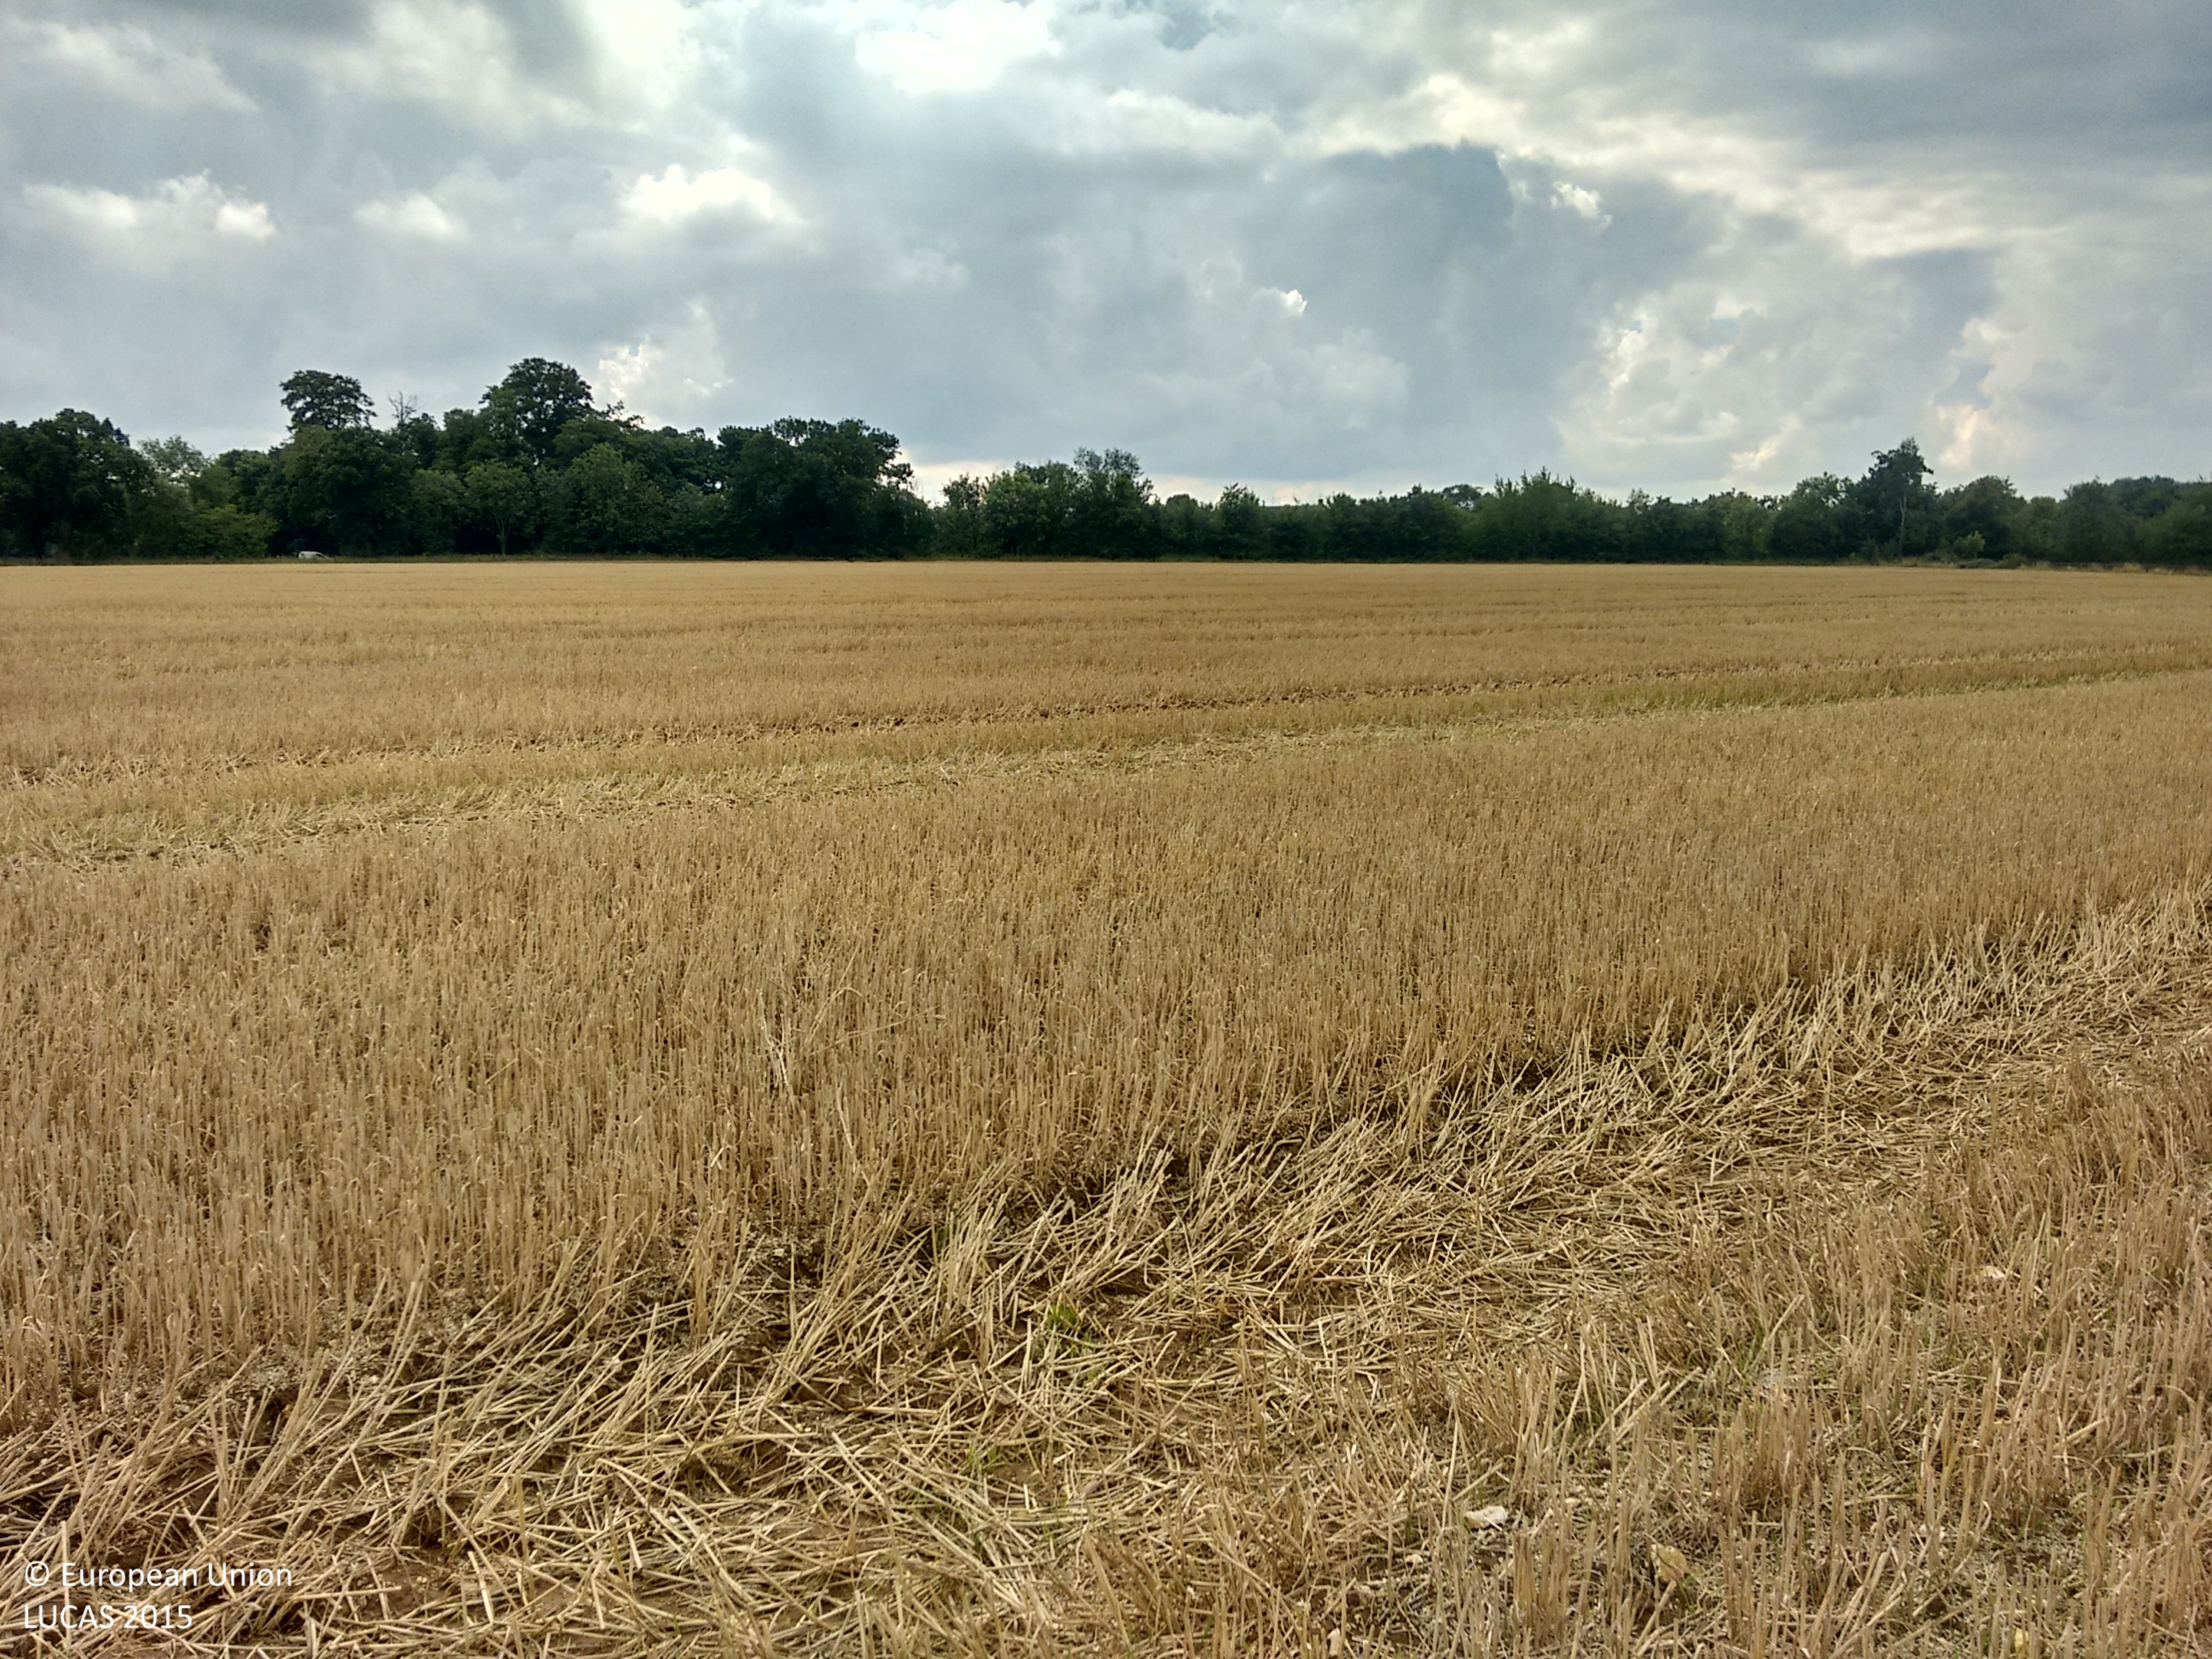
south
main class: Cropland
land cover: Common wheat
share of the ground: > 75 %
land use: Agriculture (excluding fallow land and kitchen gardens)
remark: Harvested field
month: September
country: GB
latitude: 52.2512
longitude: 0.5246
